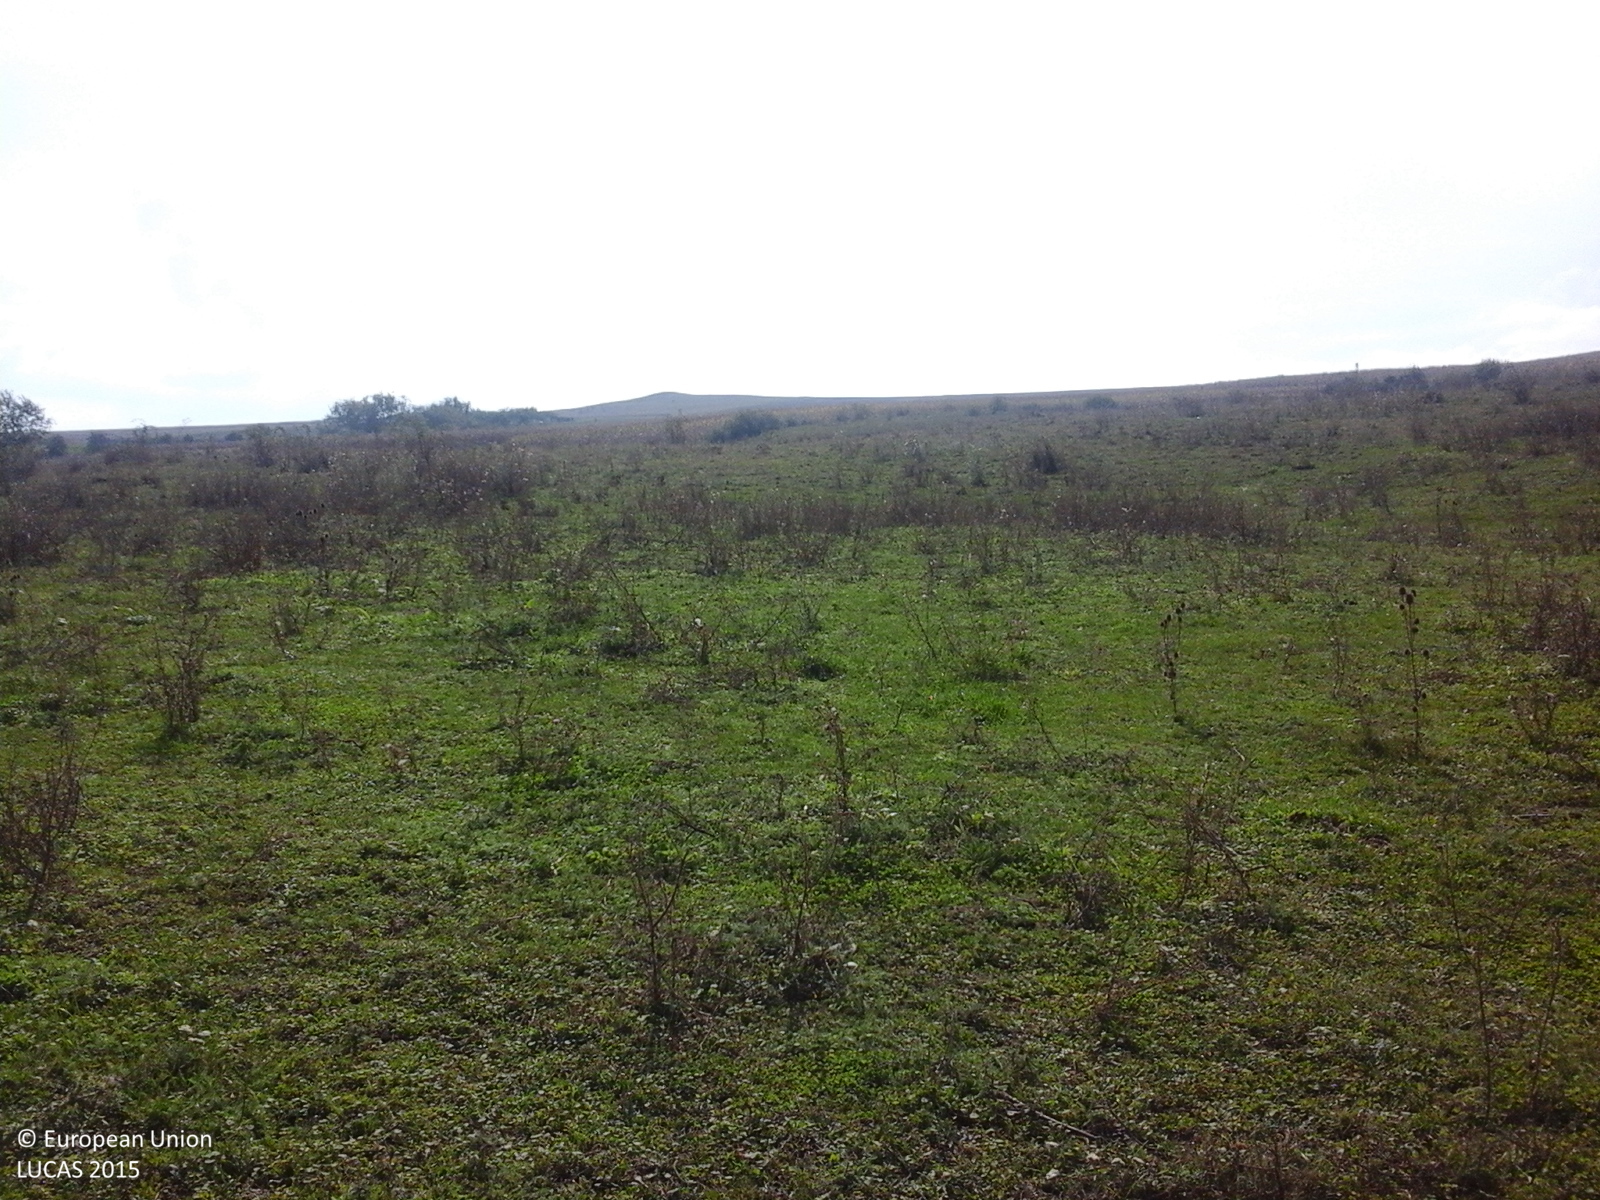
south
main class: Grassland
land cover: Spontaneously vegetated surfaces
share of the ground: > 75 %
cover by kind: herbaceous plants 100 %
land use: Agriculture (excluding fallow land and kitchen gardens)
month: October
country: RO
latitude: 46.4657
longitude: 23.8645
